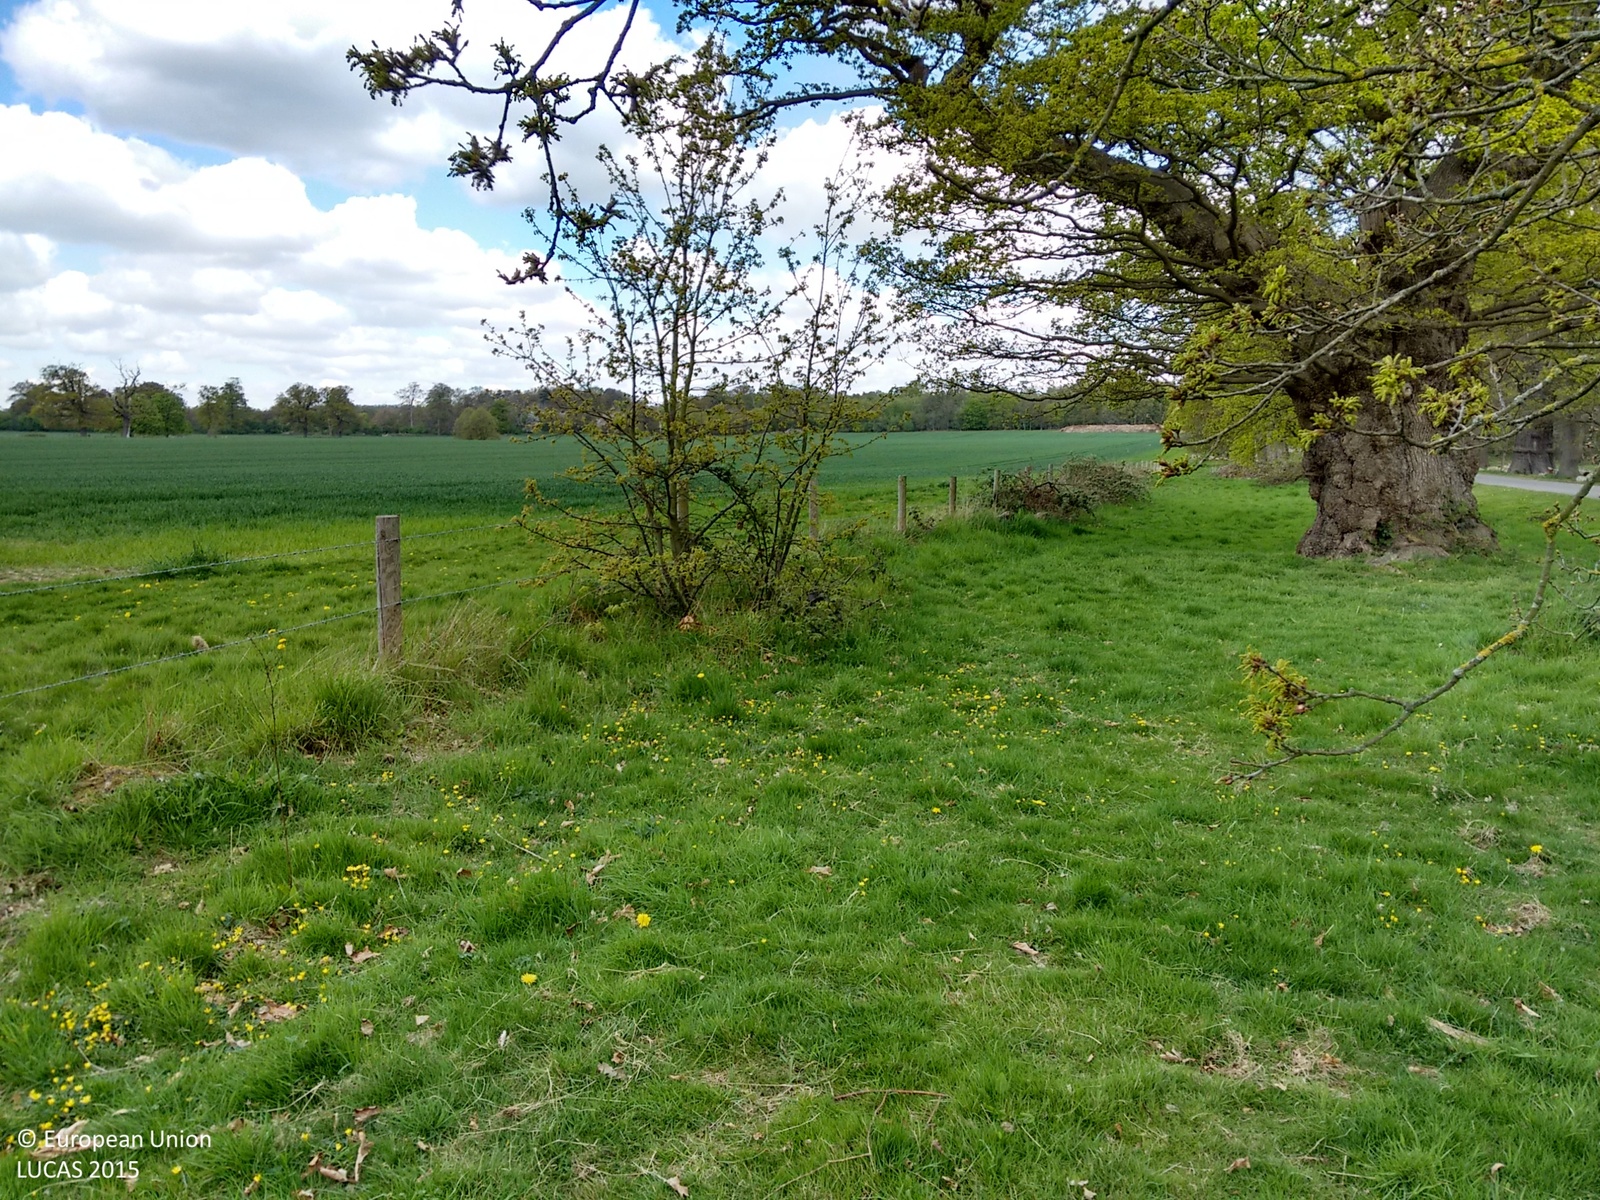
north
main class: Woodland
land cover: Broadleaved woodland
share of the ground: 50 - 75 %
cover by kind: broadleaved forest trees 50 %, herbaceous plants 50 %
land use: Residential
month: April
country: GB
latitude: 51.5255
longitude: -0.5464
